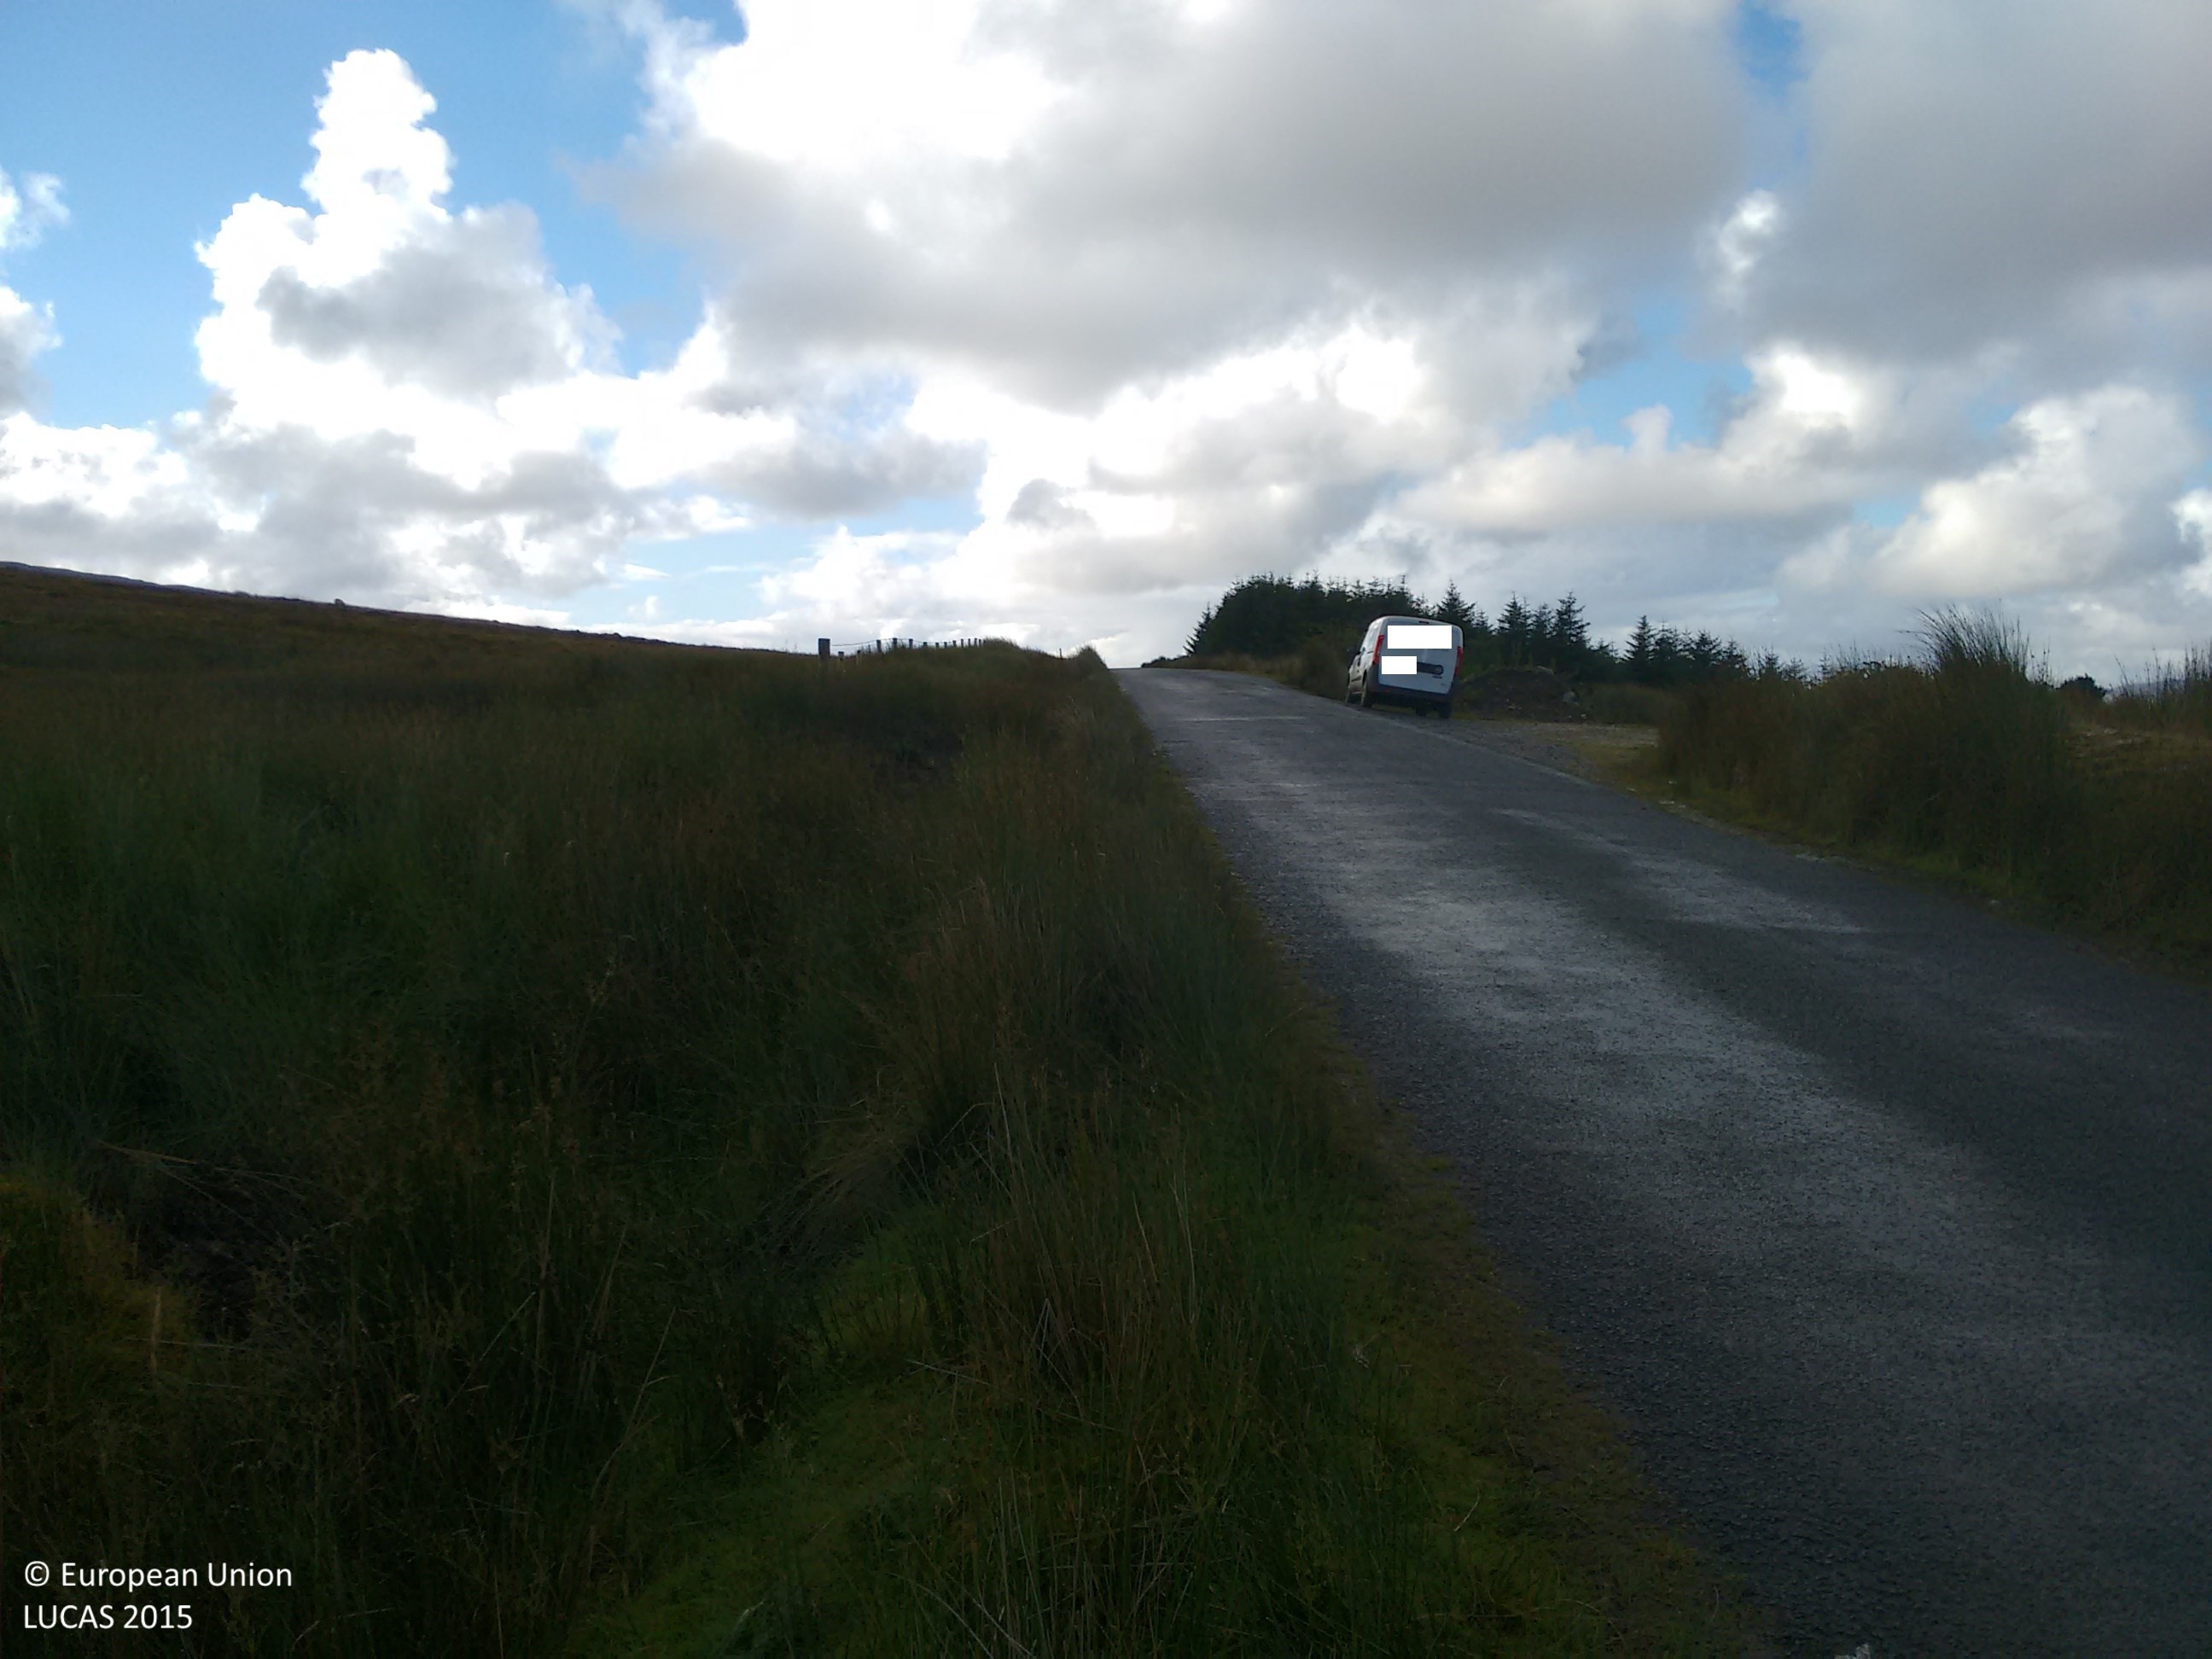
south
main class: Grassland
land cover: Grassland without tree/shrub cover
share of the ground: > 75 %
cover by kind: herbaceous plants 90 %, lichens and mosses 10 %
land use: Agriculture (excluding fallow land and kitchen gardens)
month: September
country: IE
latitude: 55.2120
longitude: -7.4877
